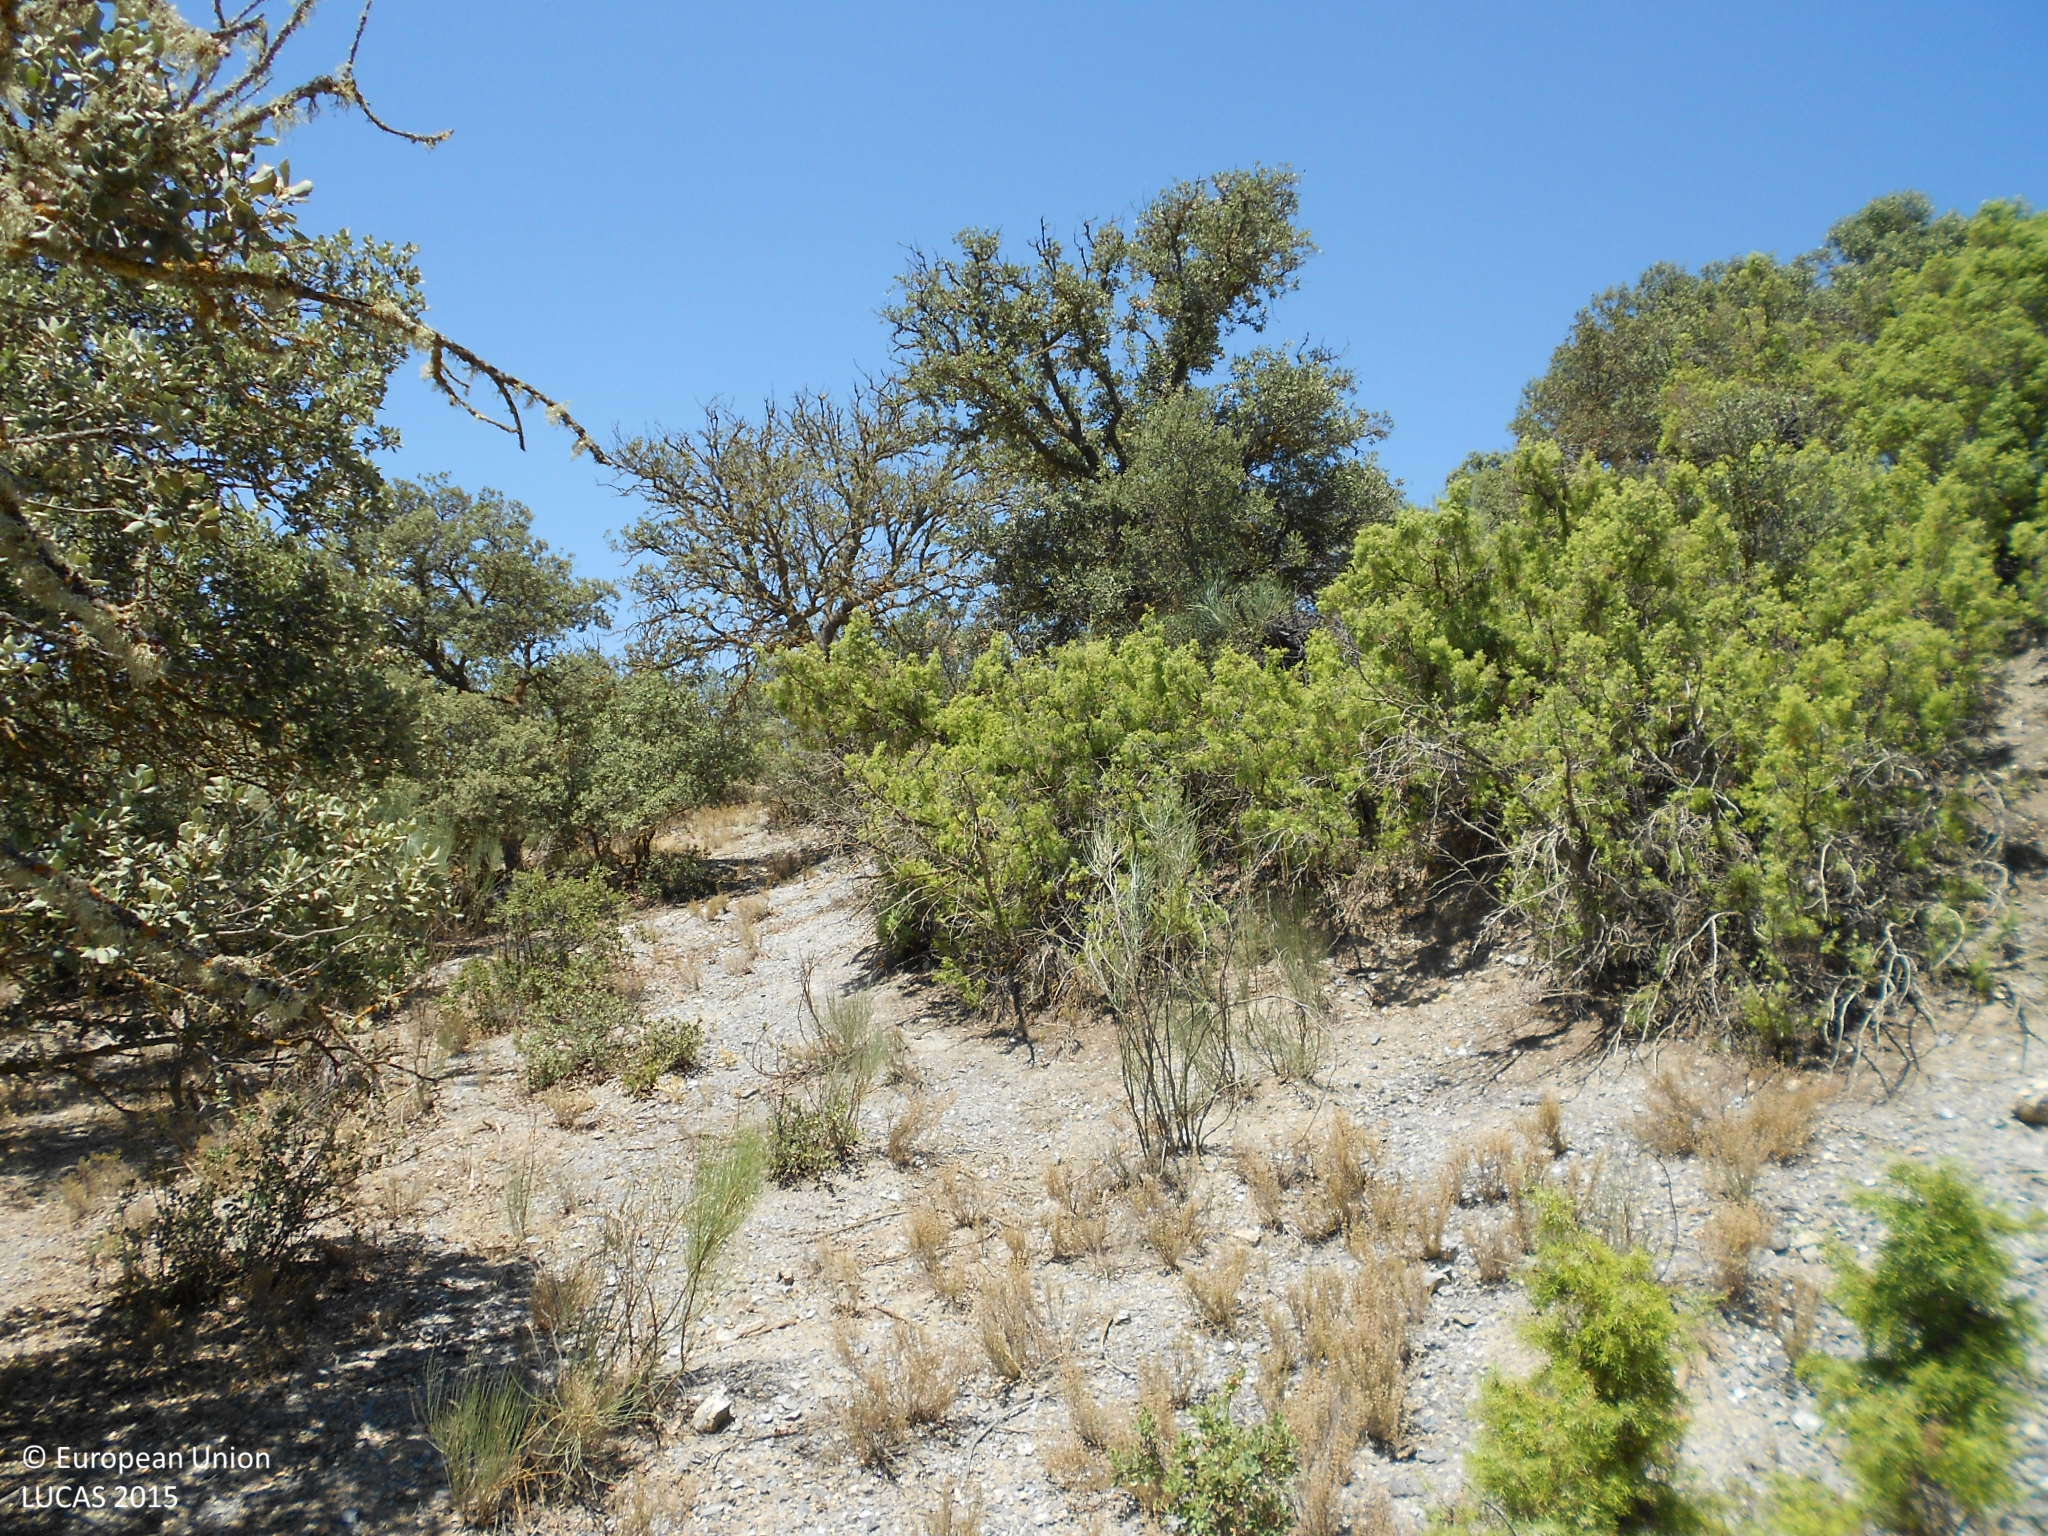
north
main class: Woodland
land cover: Broadleaved woodland
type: broadleaved evergreen forest
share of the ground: > 75 %
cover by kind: broadleaved forest trees 80 %, unconsolidated bare surface 15 %, consolidated bare surface 5 %
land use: Semi-natural and natural areas not in use
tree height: < 5 m
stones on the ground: > 50 %
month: July
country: ES
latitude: 37.5282
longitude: -2.3299
